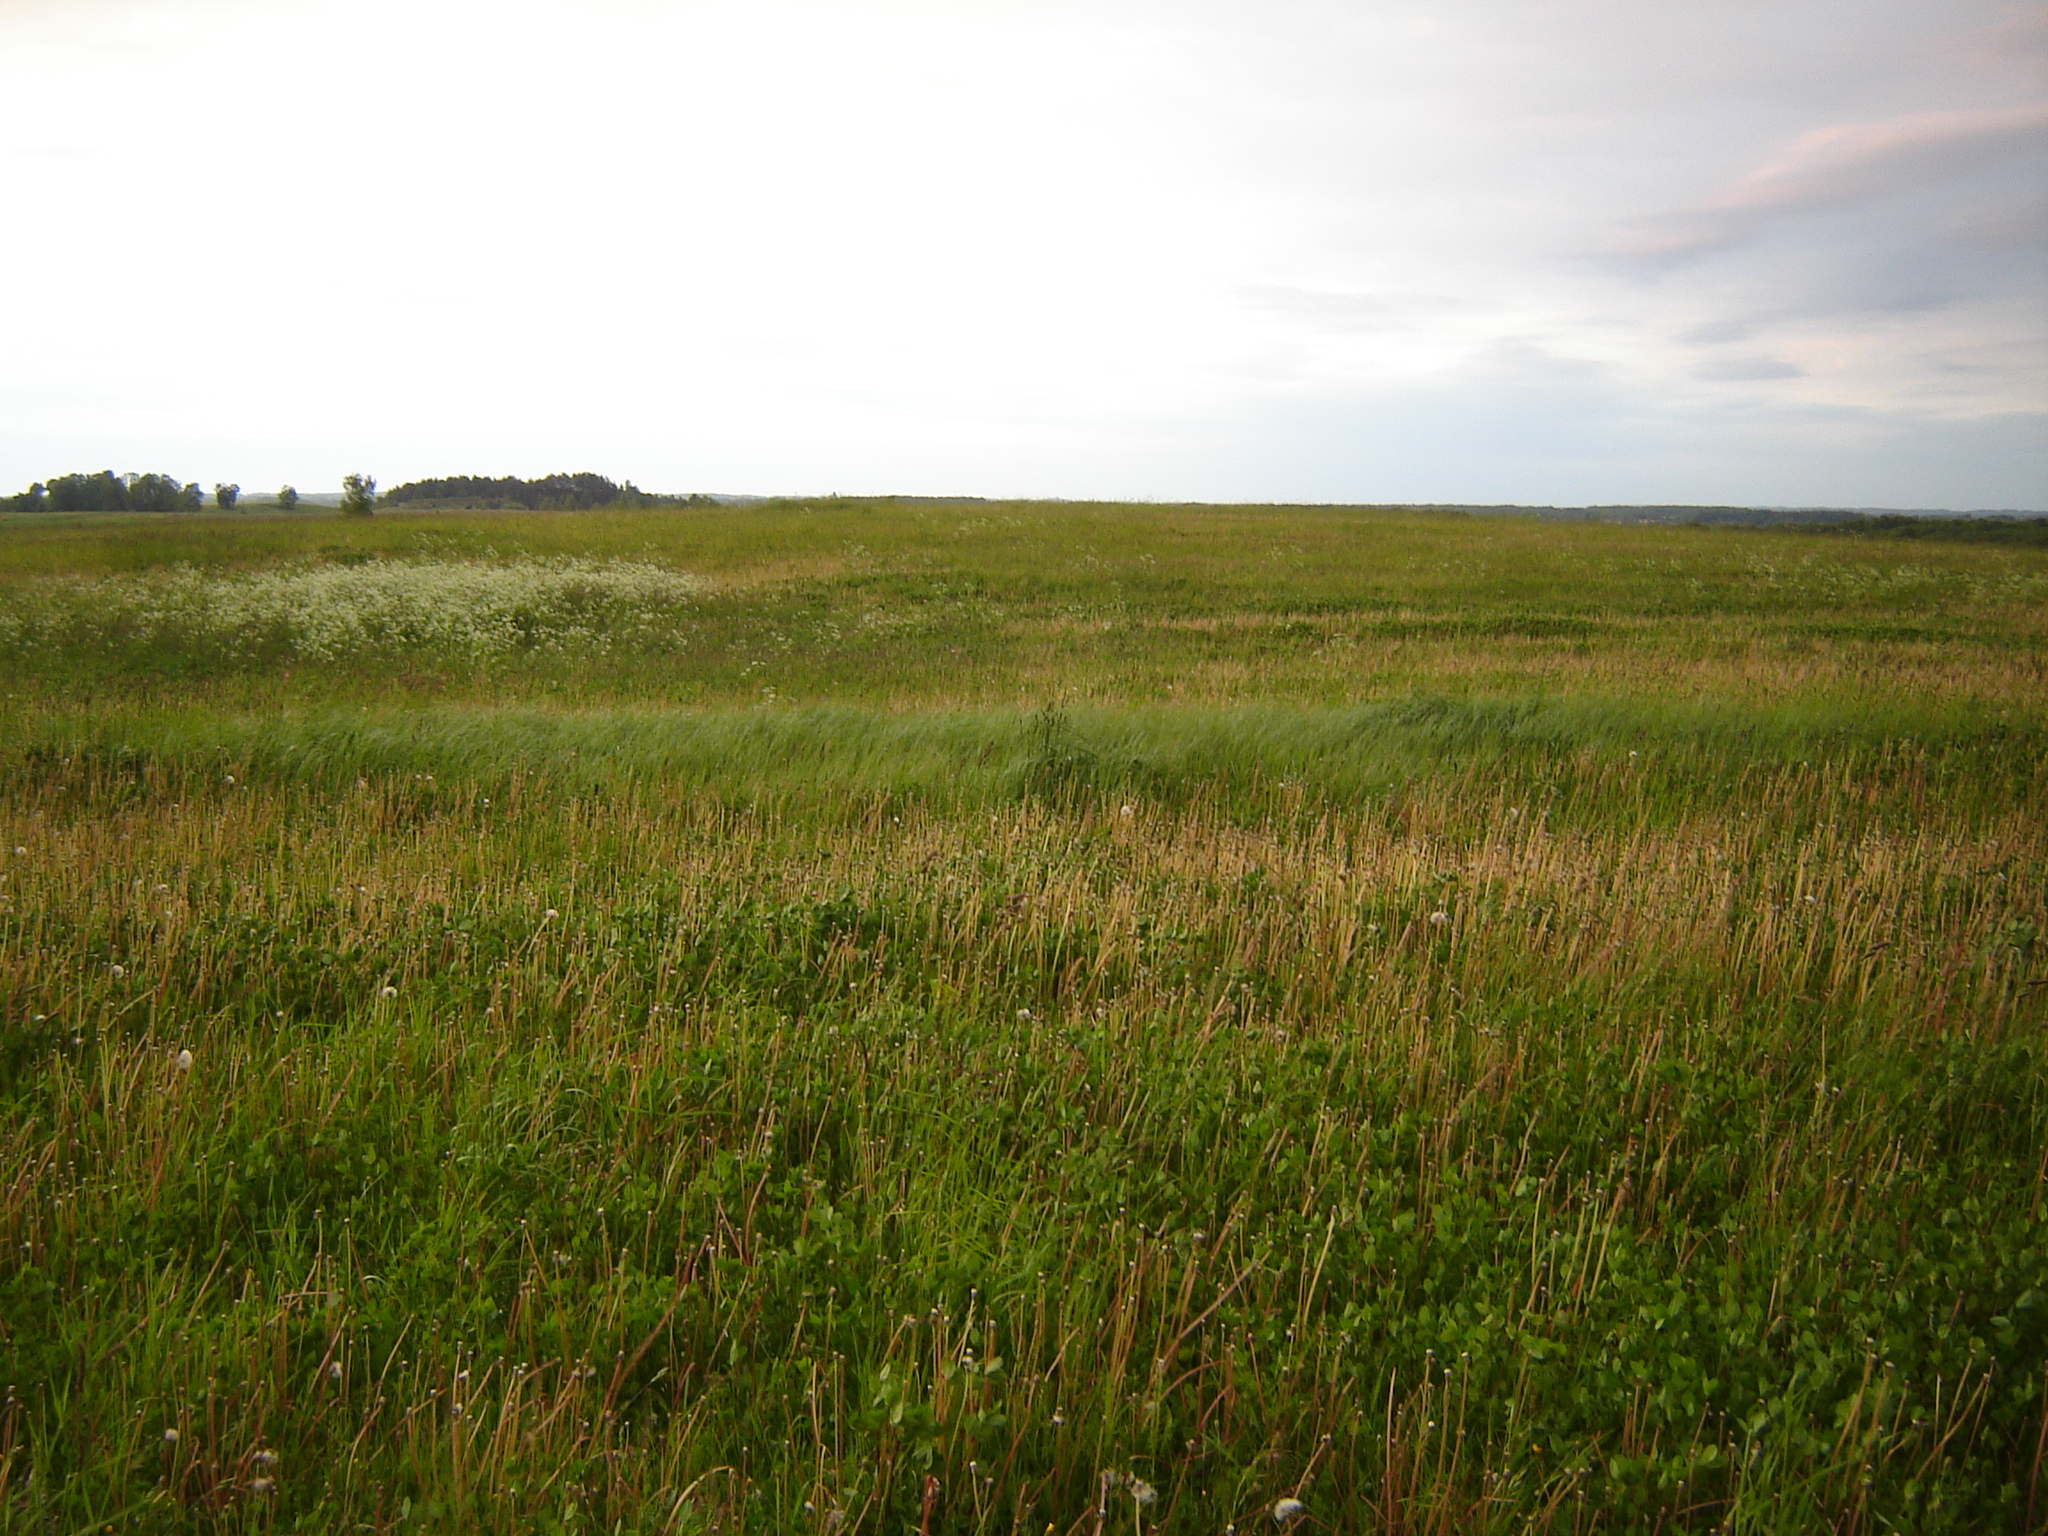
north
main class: Grassland
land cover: Grassland without tree/shrub cover
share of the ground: > 75 %
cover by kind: herbaceous plants 100 %
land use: Agriculture (excluding fallow land and kitchen gardens)
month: June
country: LT
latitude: 55.7632
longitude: 25.6993
